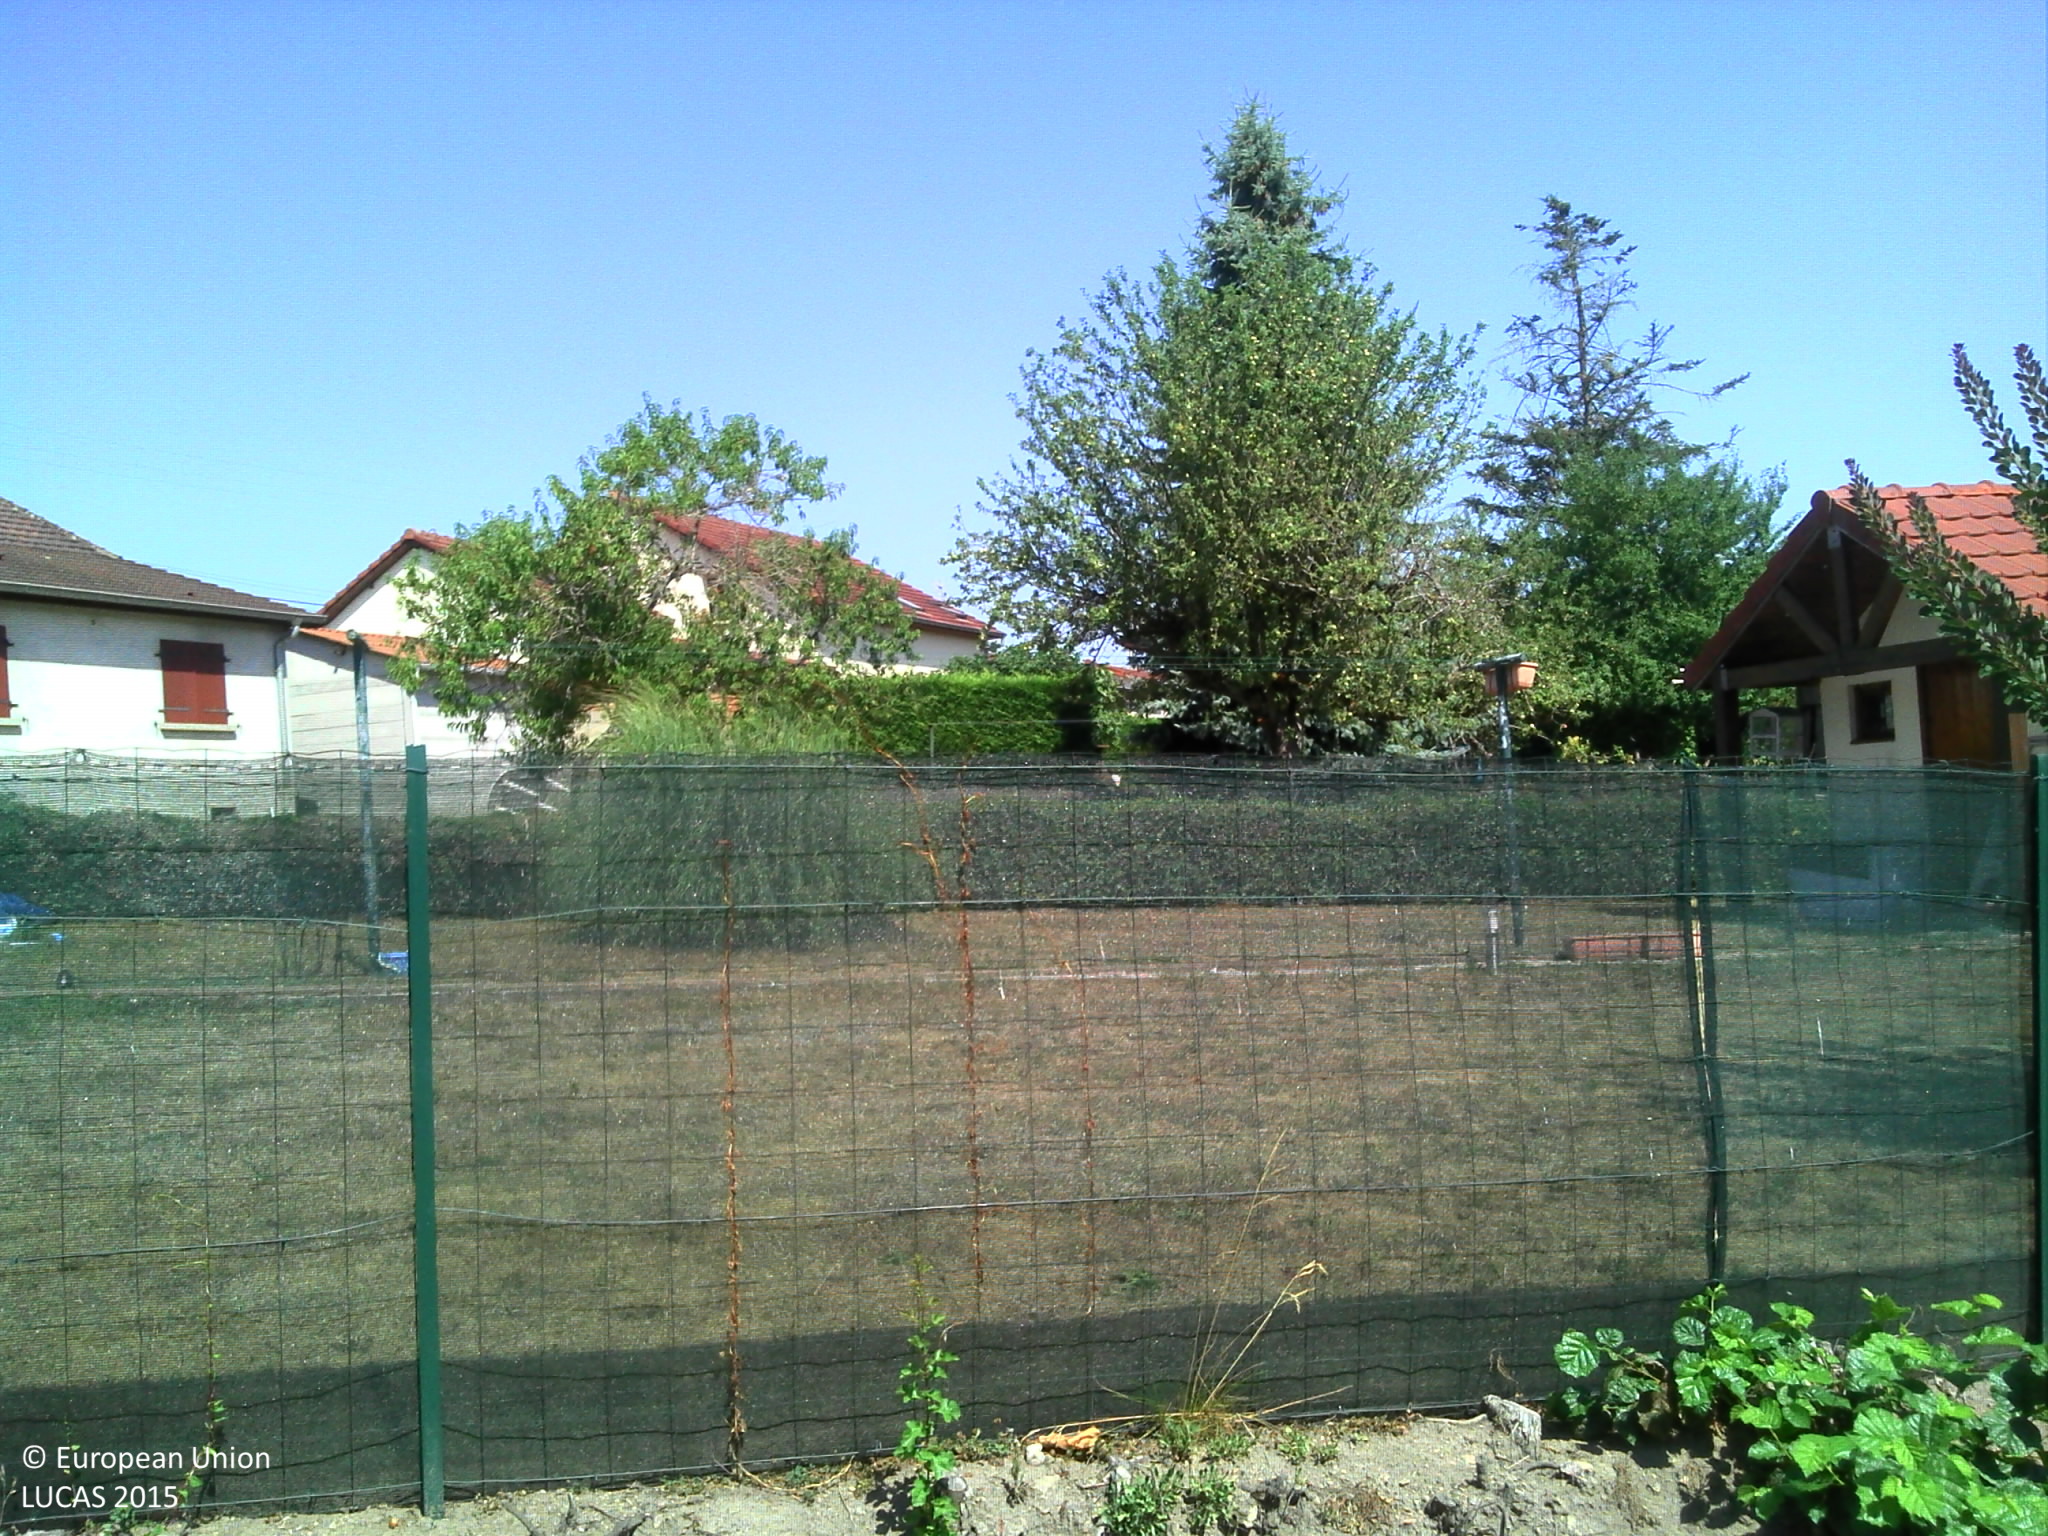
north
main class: Grassland
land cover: Grassland with sparse tree/shrub cover
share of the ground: > 75 %
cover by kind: herbaceous plants 95 %, broadleaved forest trees 5 %
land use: Residential
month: August
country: FR
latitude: 46.8032
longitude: 4.4579
